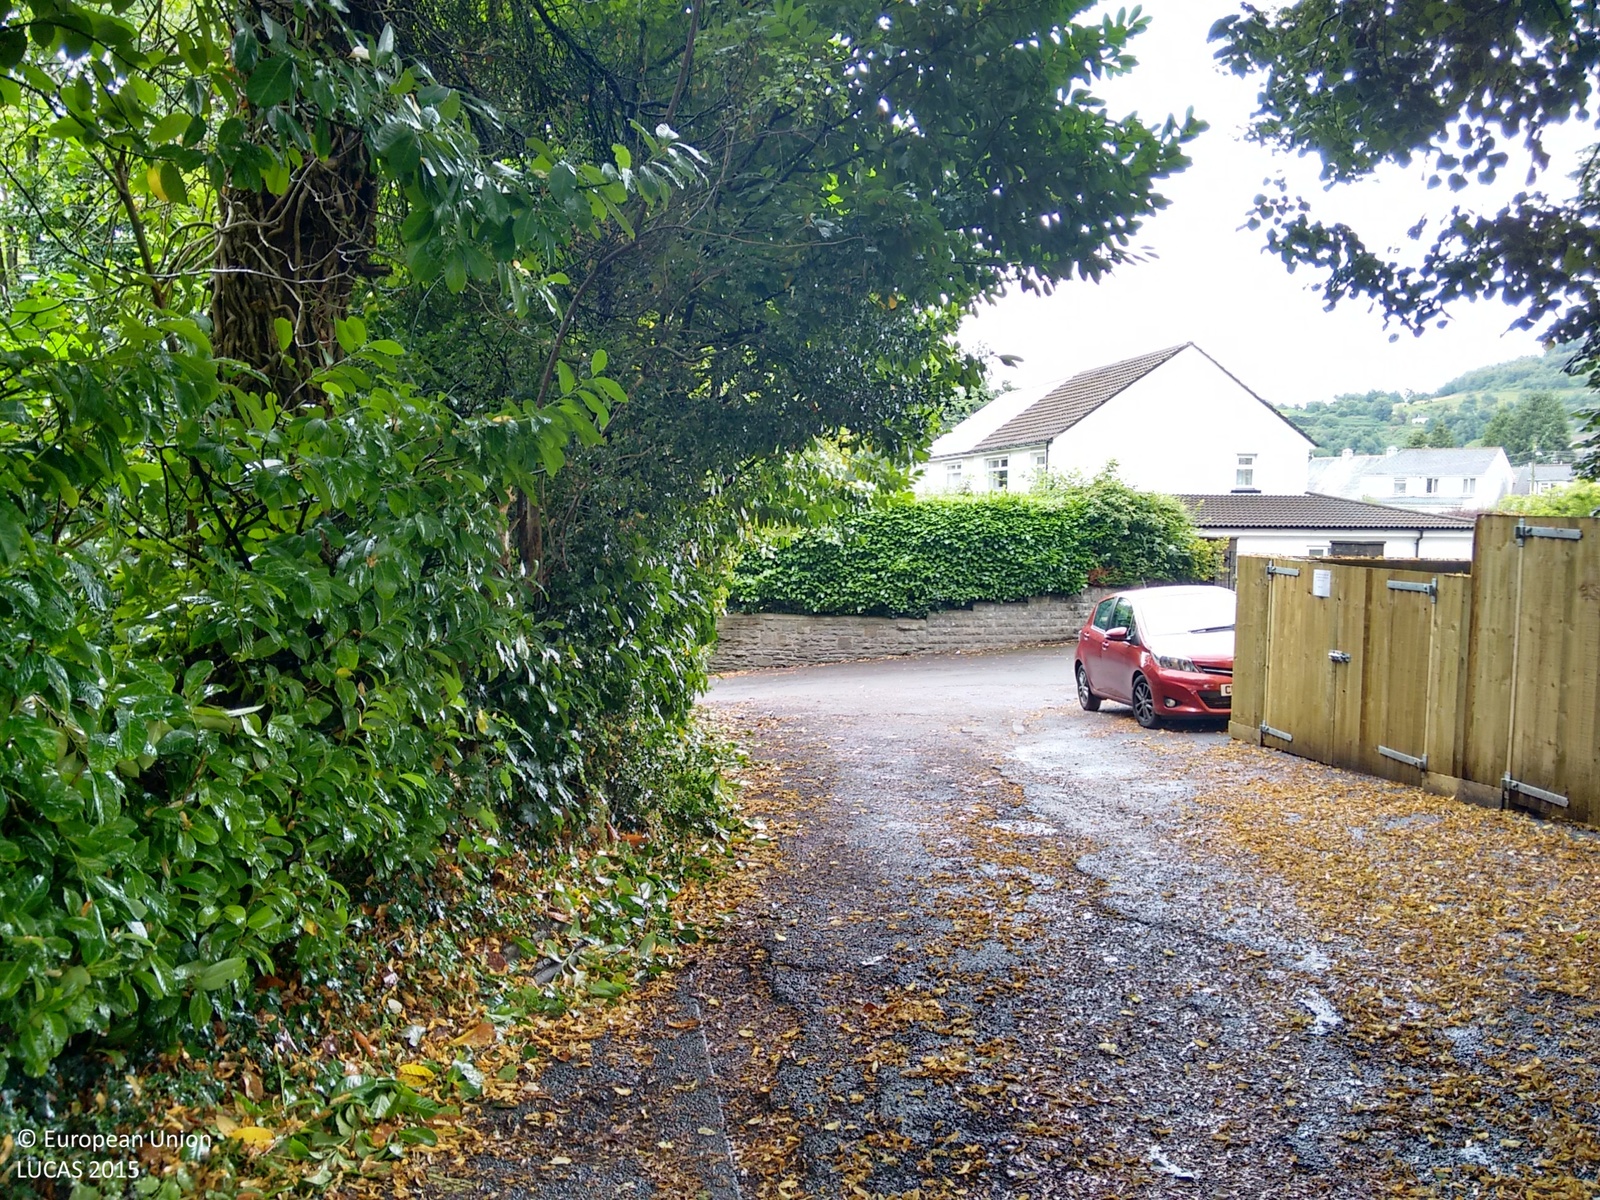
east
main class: Grassland
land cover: Grassland without tree/shrub cover
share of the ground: > 75 %
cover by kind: herbaceous plants 100 %
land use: Residential
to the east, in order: Grassland without tree/shrub cover; Broadleaved woodland; Fences; Paved roads, cycling and walking lanes; Lines of trees; Grassland without tree/shrub cover; Tracks; Broadleaved woodland; Fences; Broadleaved woodland; Dry stone walls; Artificial constructions in urban areas; Broadleaved woodland; Inland fresh running water; Broadleaved woodland
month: July
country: GB
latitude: 51.6008
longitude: -3.3496
